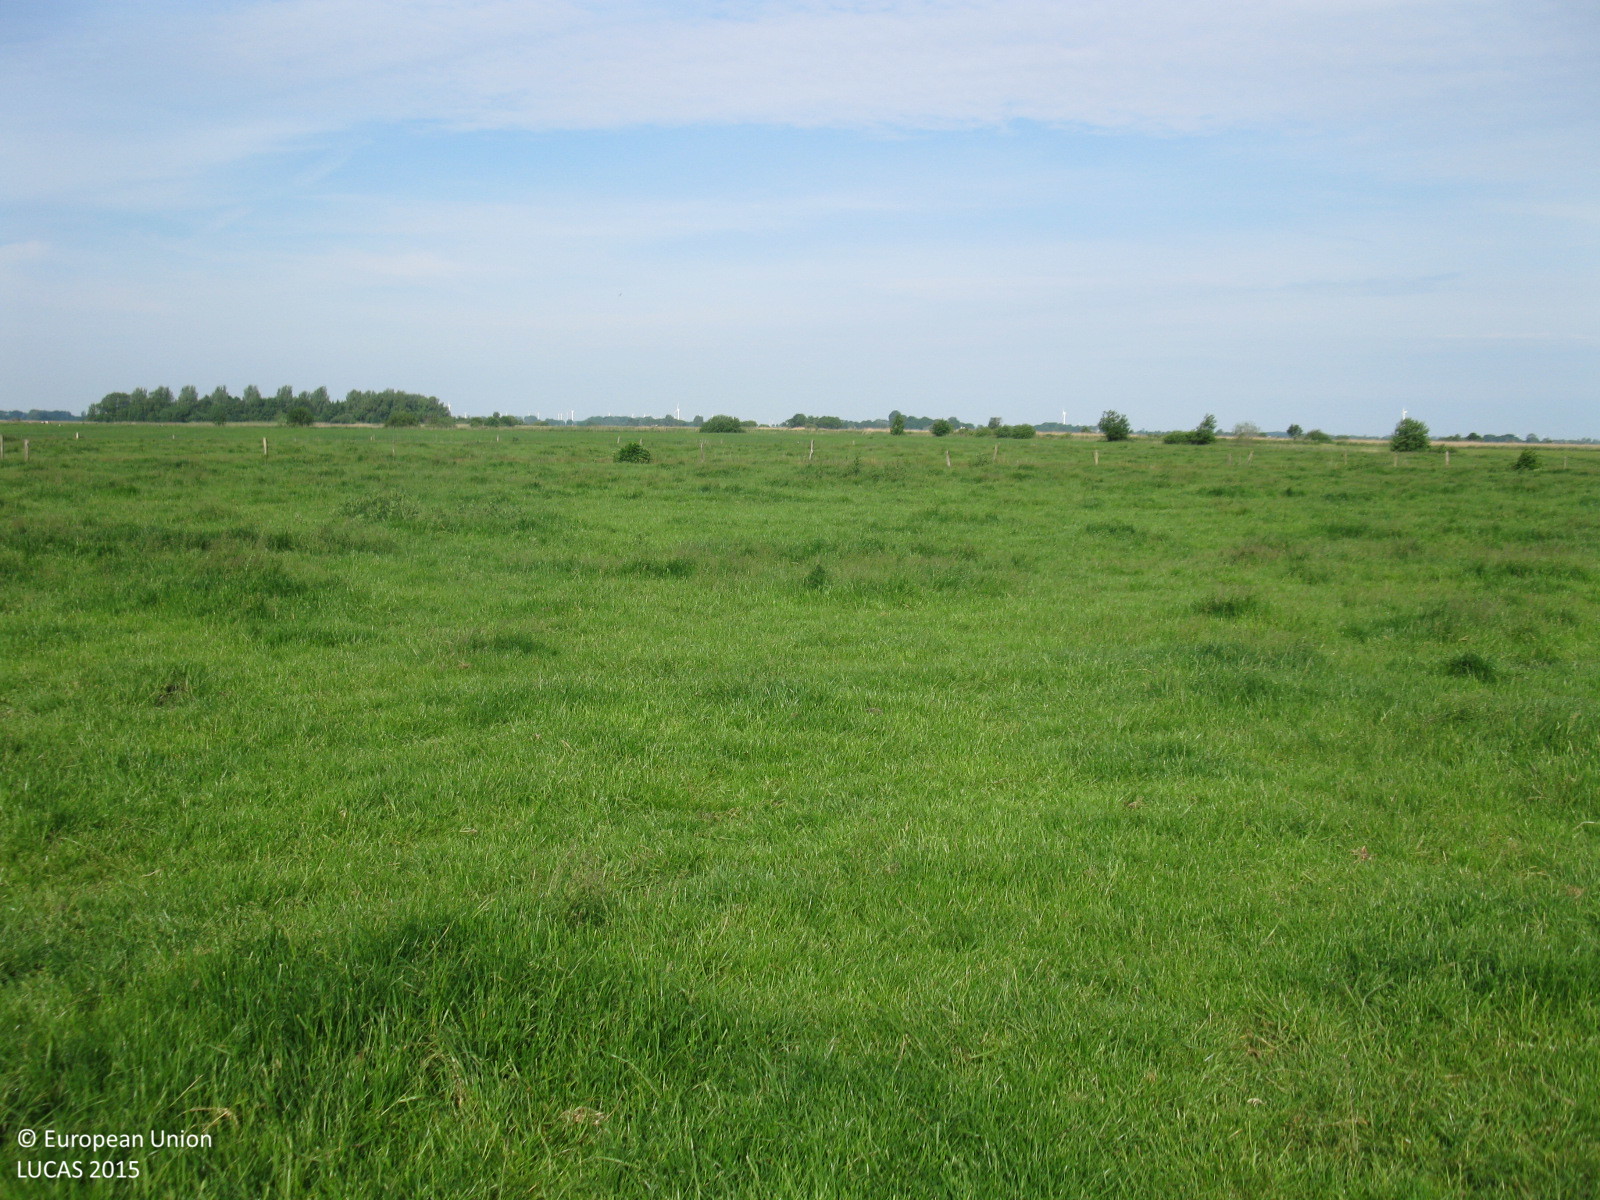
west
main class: Grassland
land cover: Grassland without tree/shrub cover
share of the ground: > 75 %
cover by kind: herbaceous plants 100 %
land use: Agriculture (excluding fallow land and kitchen gardens)
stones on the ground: < 10 %
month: June
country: DE
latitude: 53.4612
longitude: 7.2745
